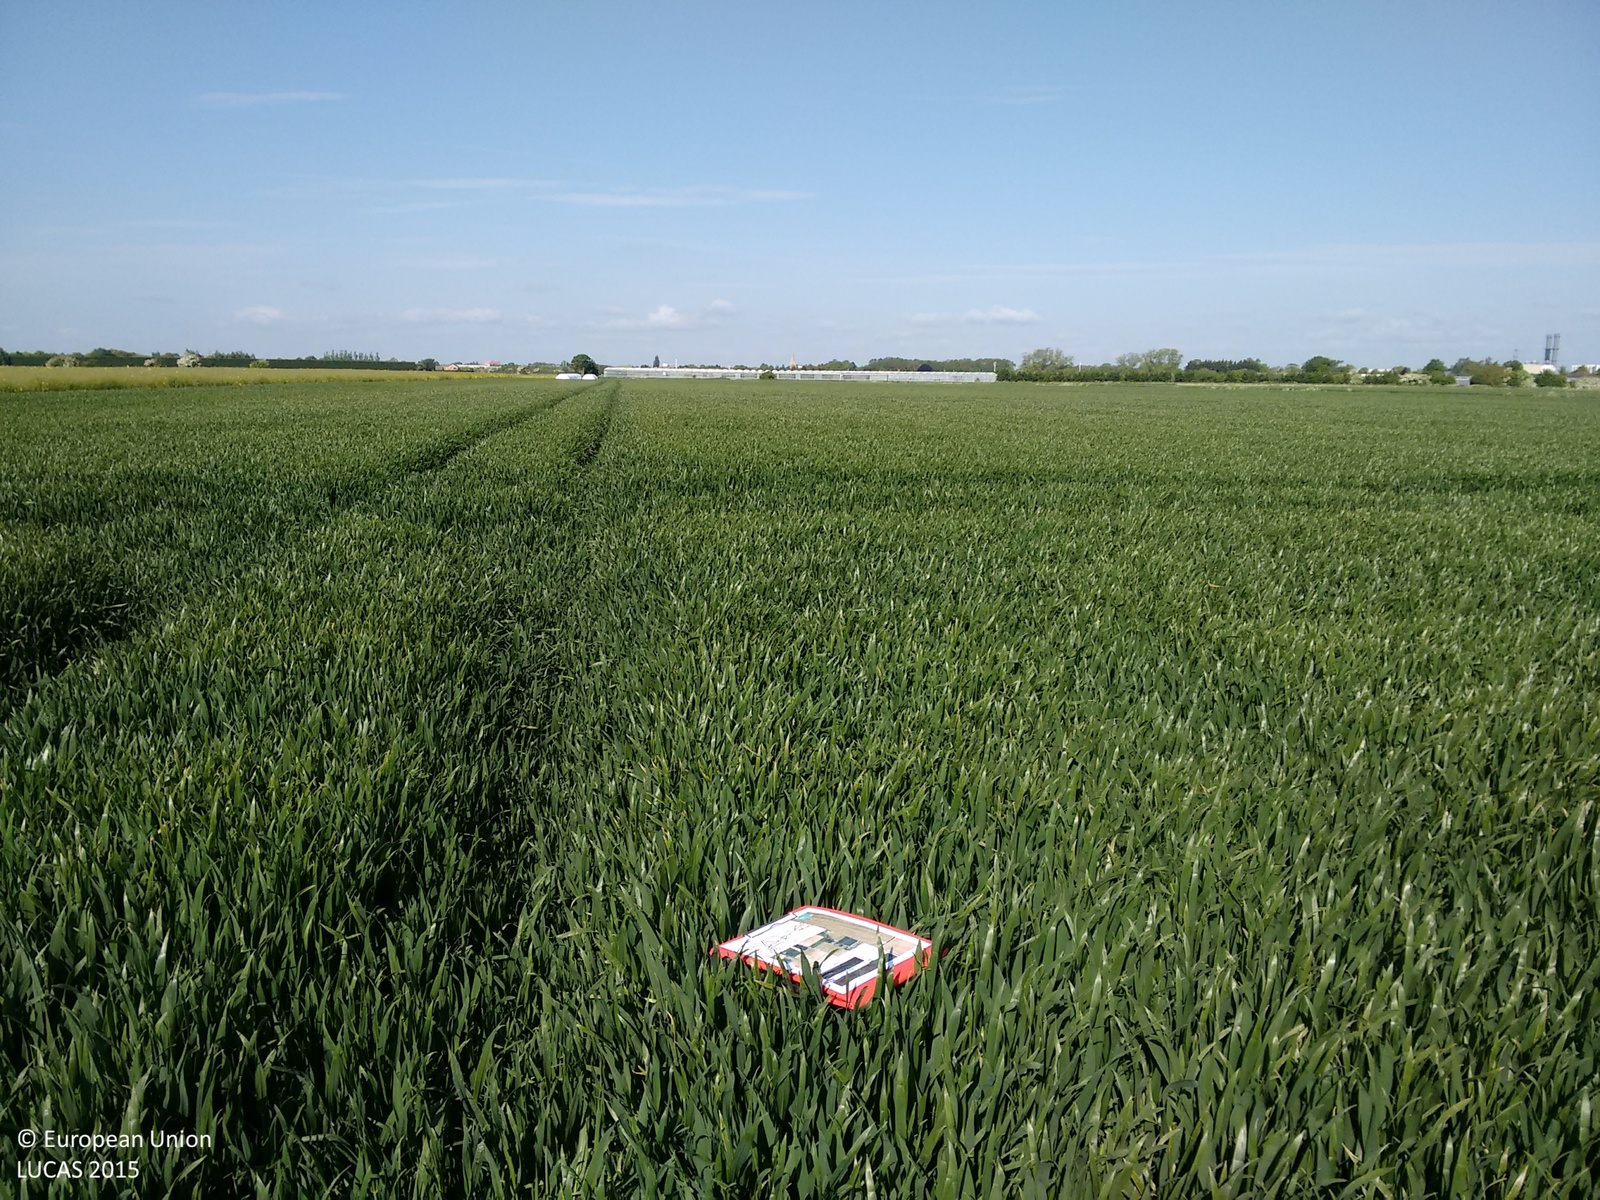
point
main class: Cropland
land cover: Common wheat
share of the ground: > 75 %
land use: Agriculture (excluding fallow land and kitchen gardens)
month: May
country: GB
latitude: 52.7971
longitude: -0.1037
